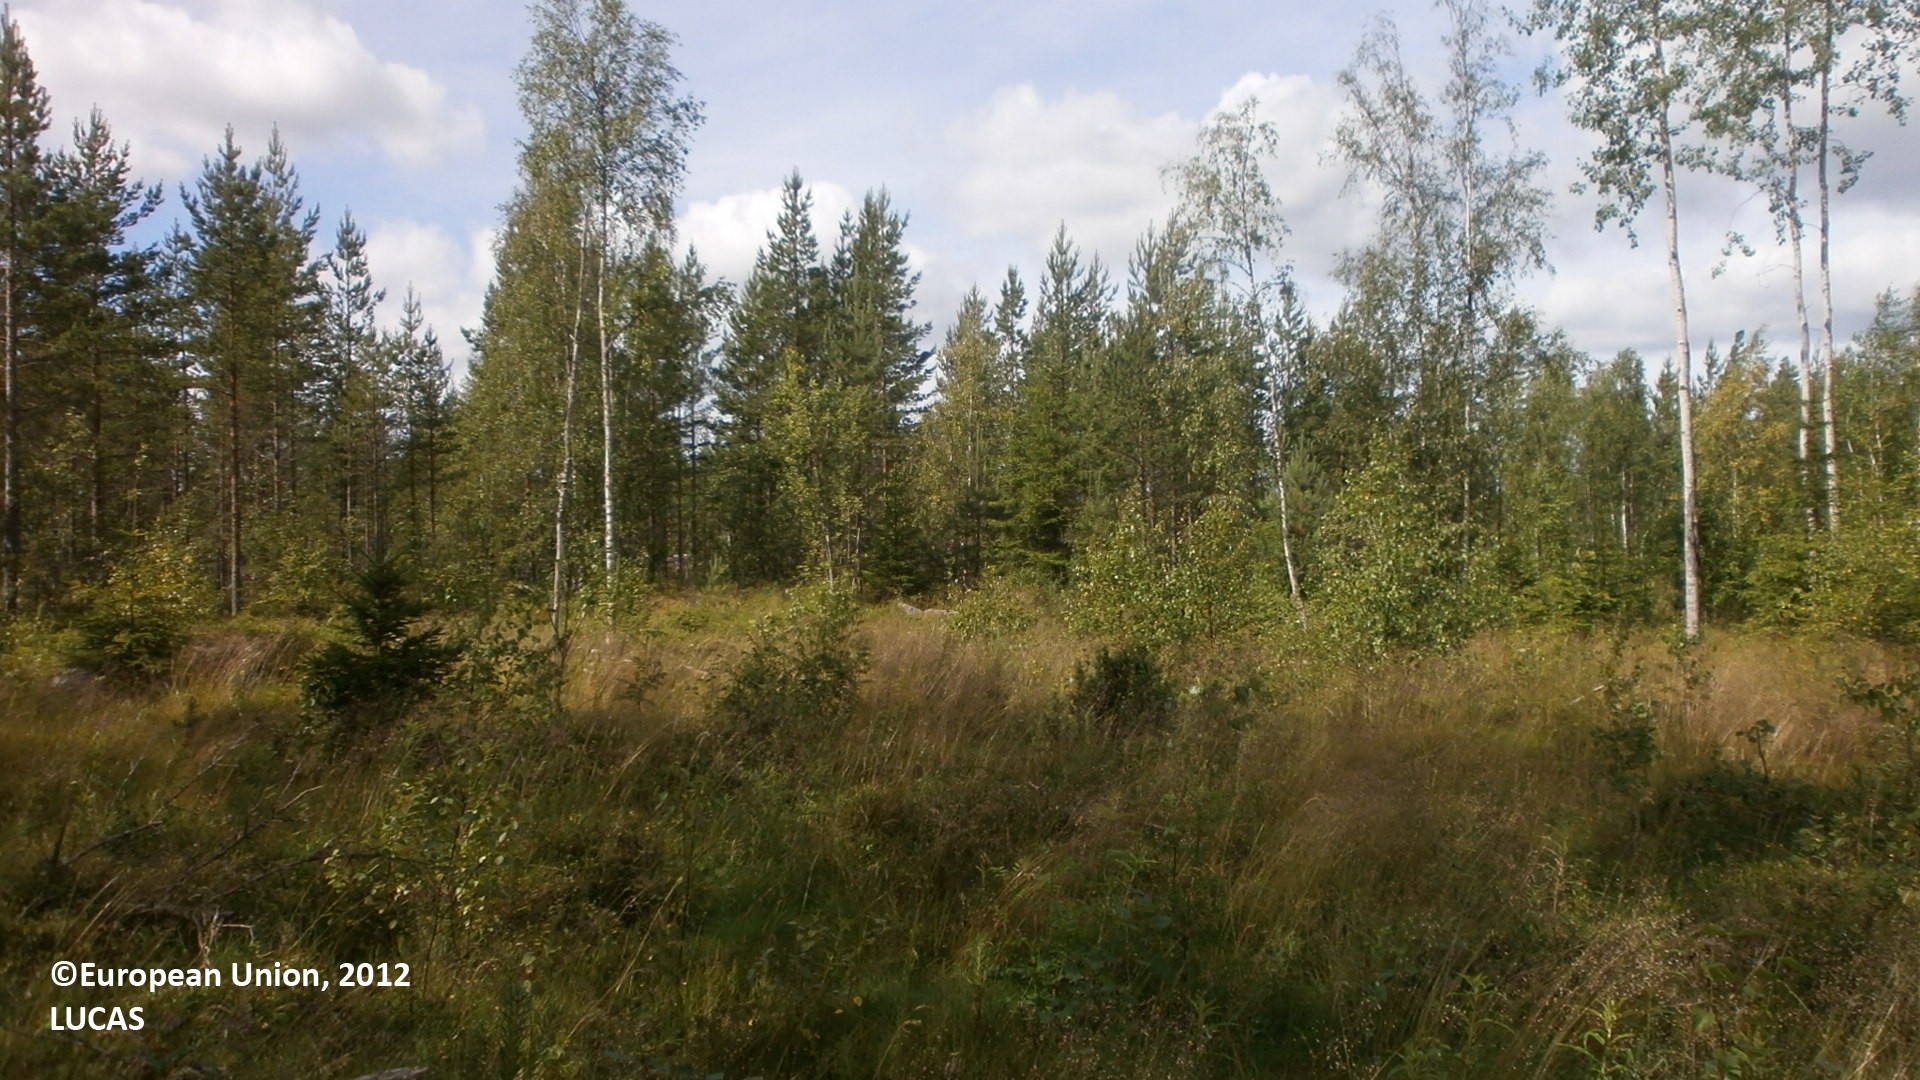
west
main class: Shrubland
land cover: Shrubland with sparse tree cover
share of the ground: > 75 %
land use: Forestry
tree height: < 5 m
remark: Clear cut
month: July
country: FI
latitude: 64.0443
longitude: 24.2611
